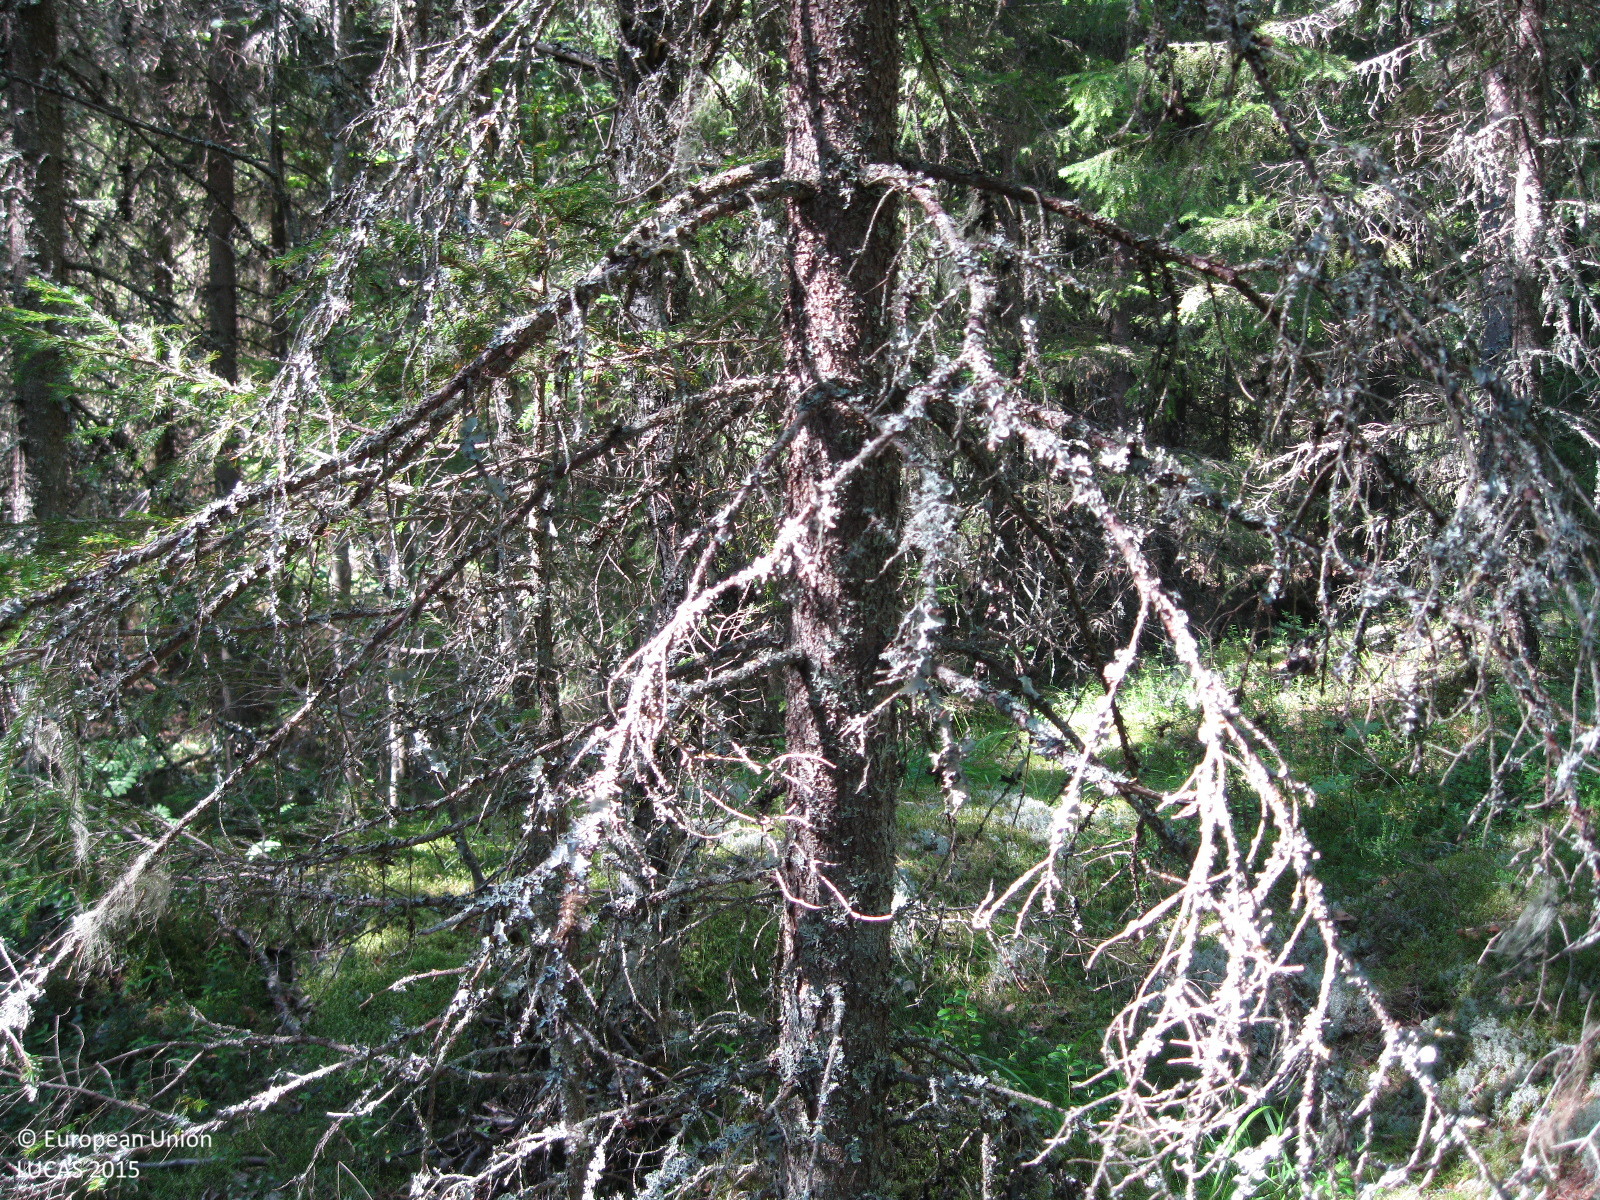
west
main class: Woodland
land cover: Other coniferous woodland
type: boreal forest
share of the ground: 50 - 75 %
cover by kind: coniferous forest trees 50 %, lichens and mosses 25 %, shrubs 15 %, broadleaved forest trees 10 %
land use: Forestry
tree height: > 5 m
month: August
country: FI
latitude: 61.4535
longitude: 25.1387
